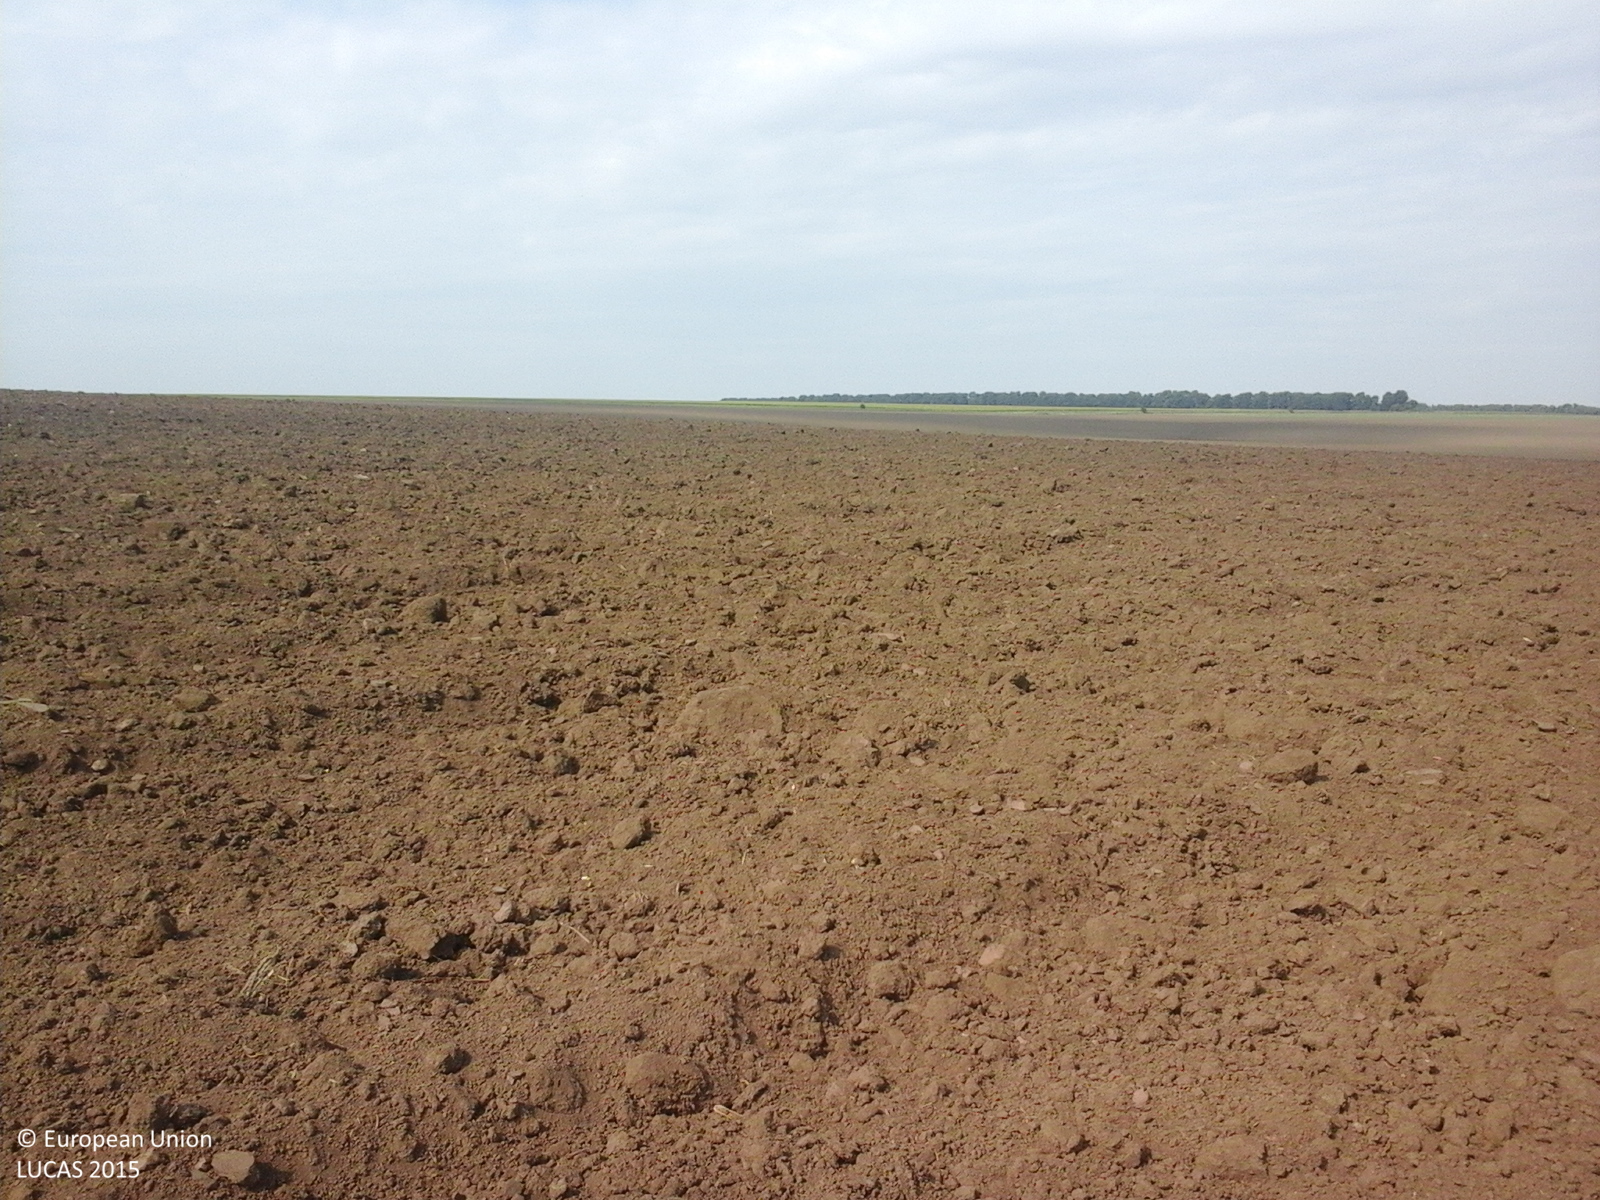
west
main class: Cropland
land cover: Common wheat
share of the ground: < 10 %
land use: Agriculture (excluding fallow land and kitchen gardens)
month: August
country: RO
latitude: 43.8140
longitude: 28.0919
